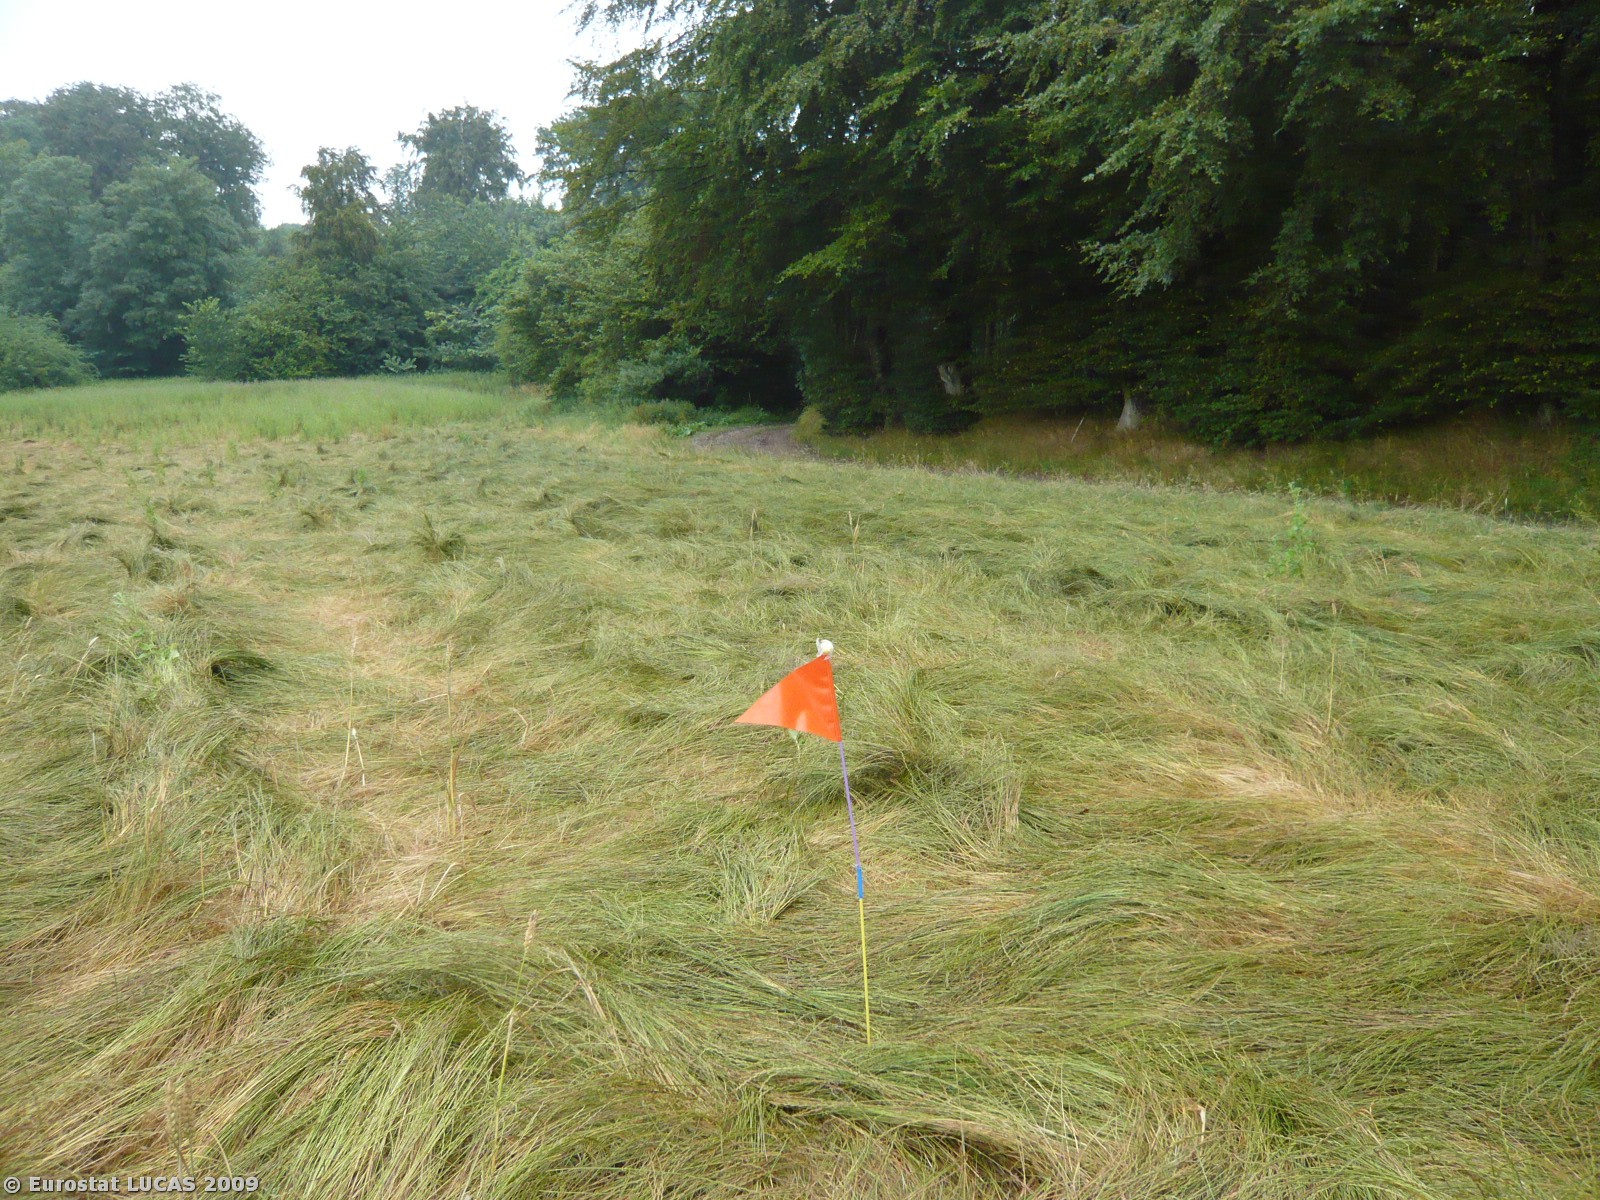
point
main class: Cropland
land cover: Temporary grasslands
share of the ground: > 75 %
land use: Agriculture (excluding fallow land and kitchen gardens)
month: July
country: DK
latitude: 55.6709
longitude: 11.8586
